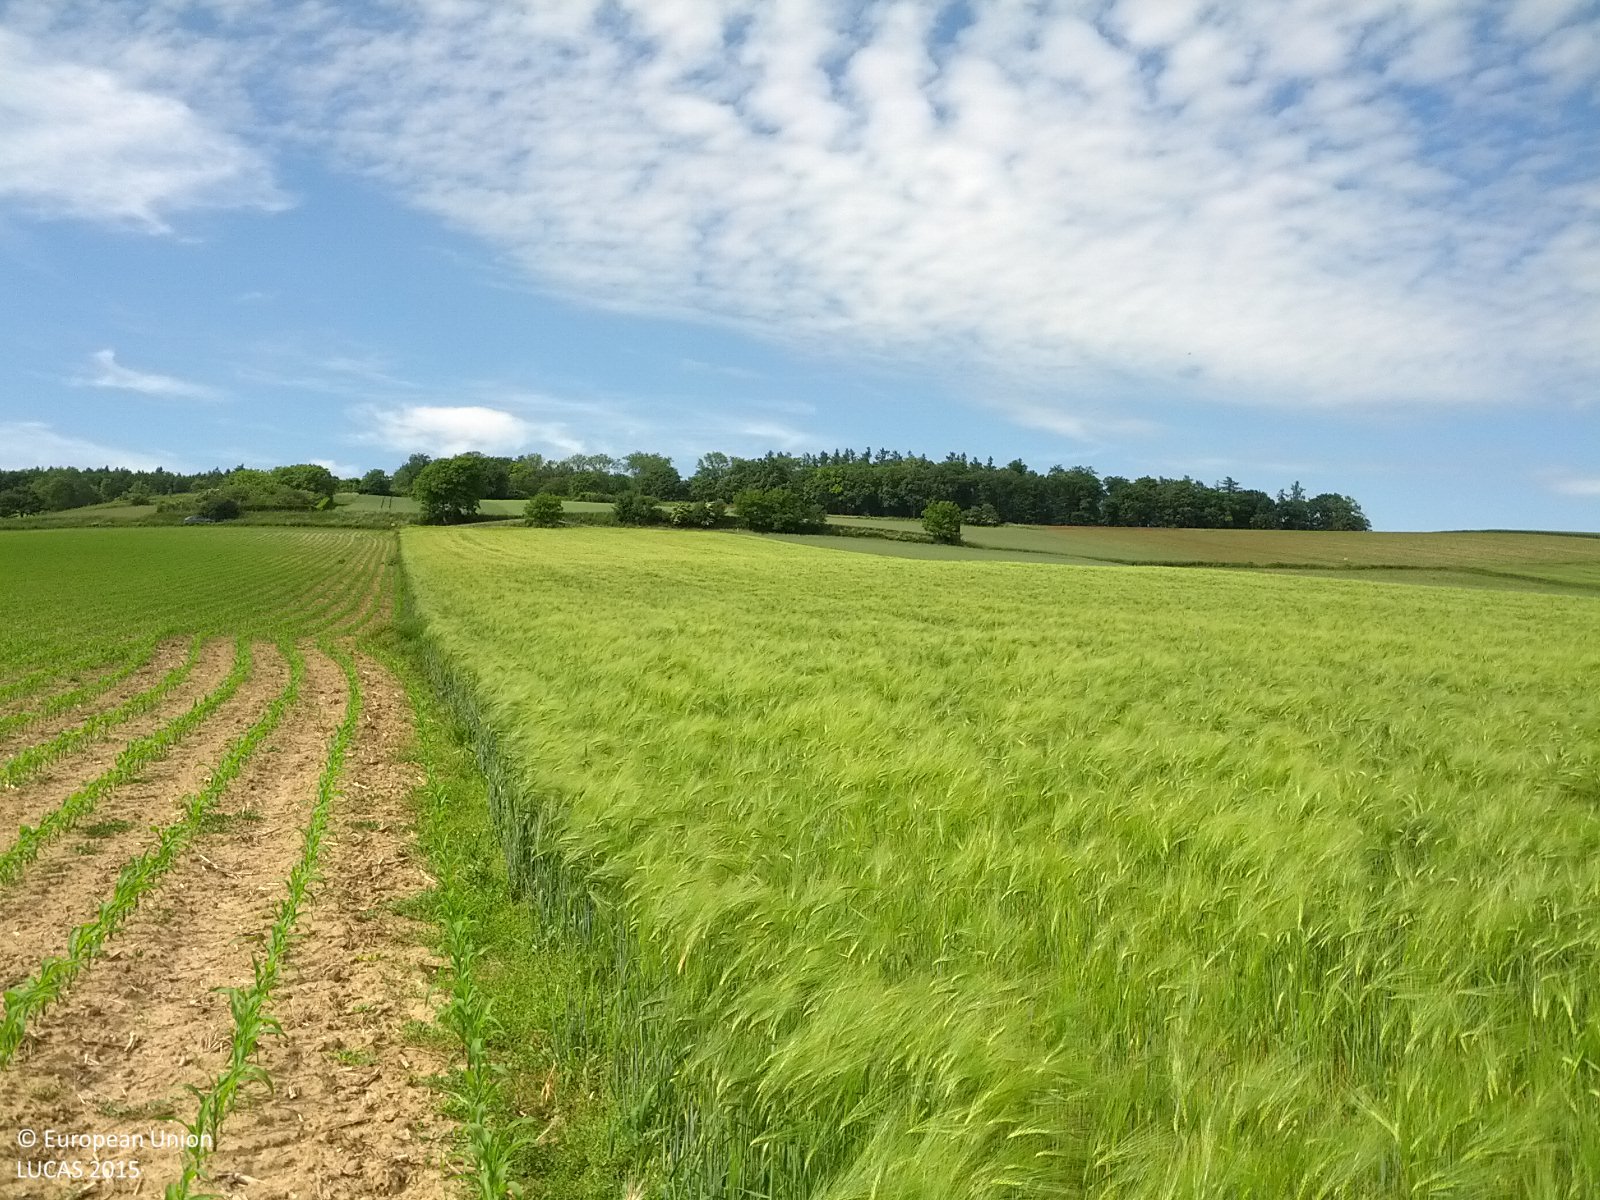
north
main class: Cropland
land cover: Barley
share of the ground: > 75 %
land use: Agriculture (excluding fallow land and kitchen gardens)
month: June
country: AT
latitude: 48.2558
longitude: 16.0516
